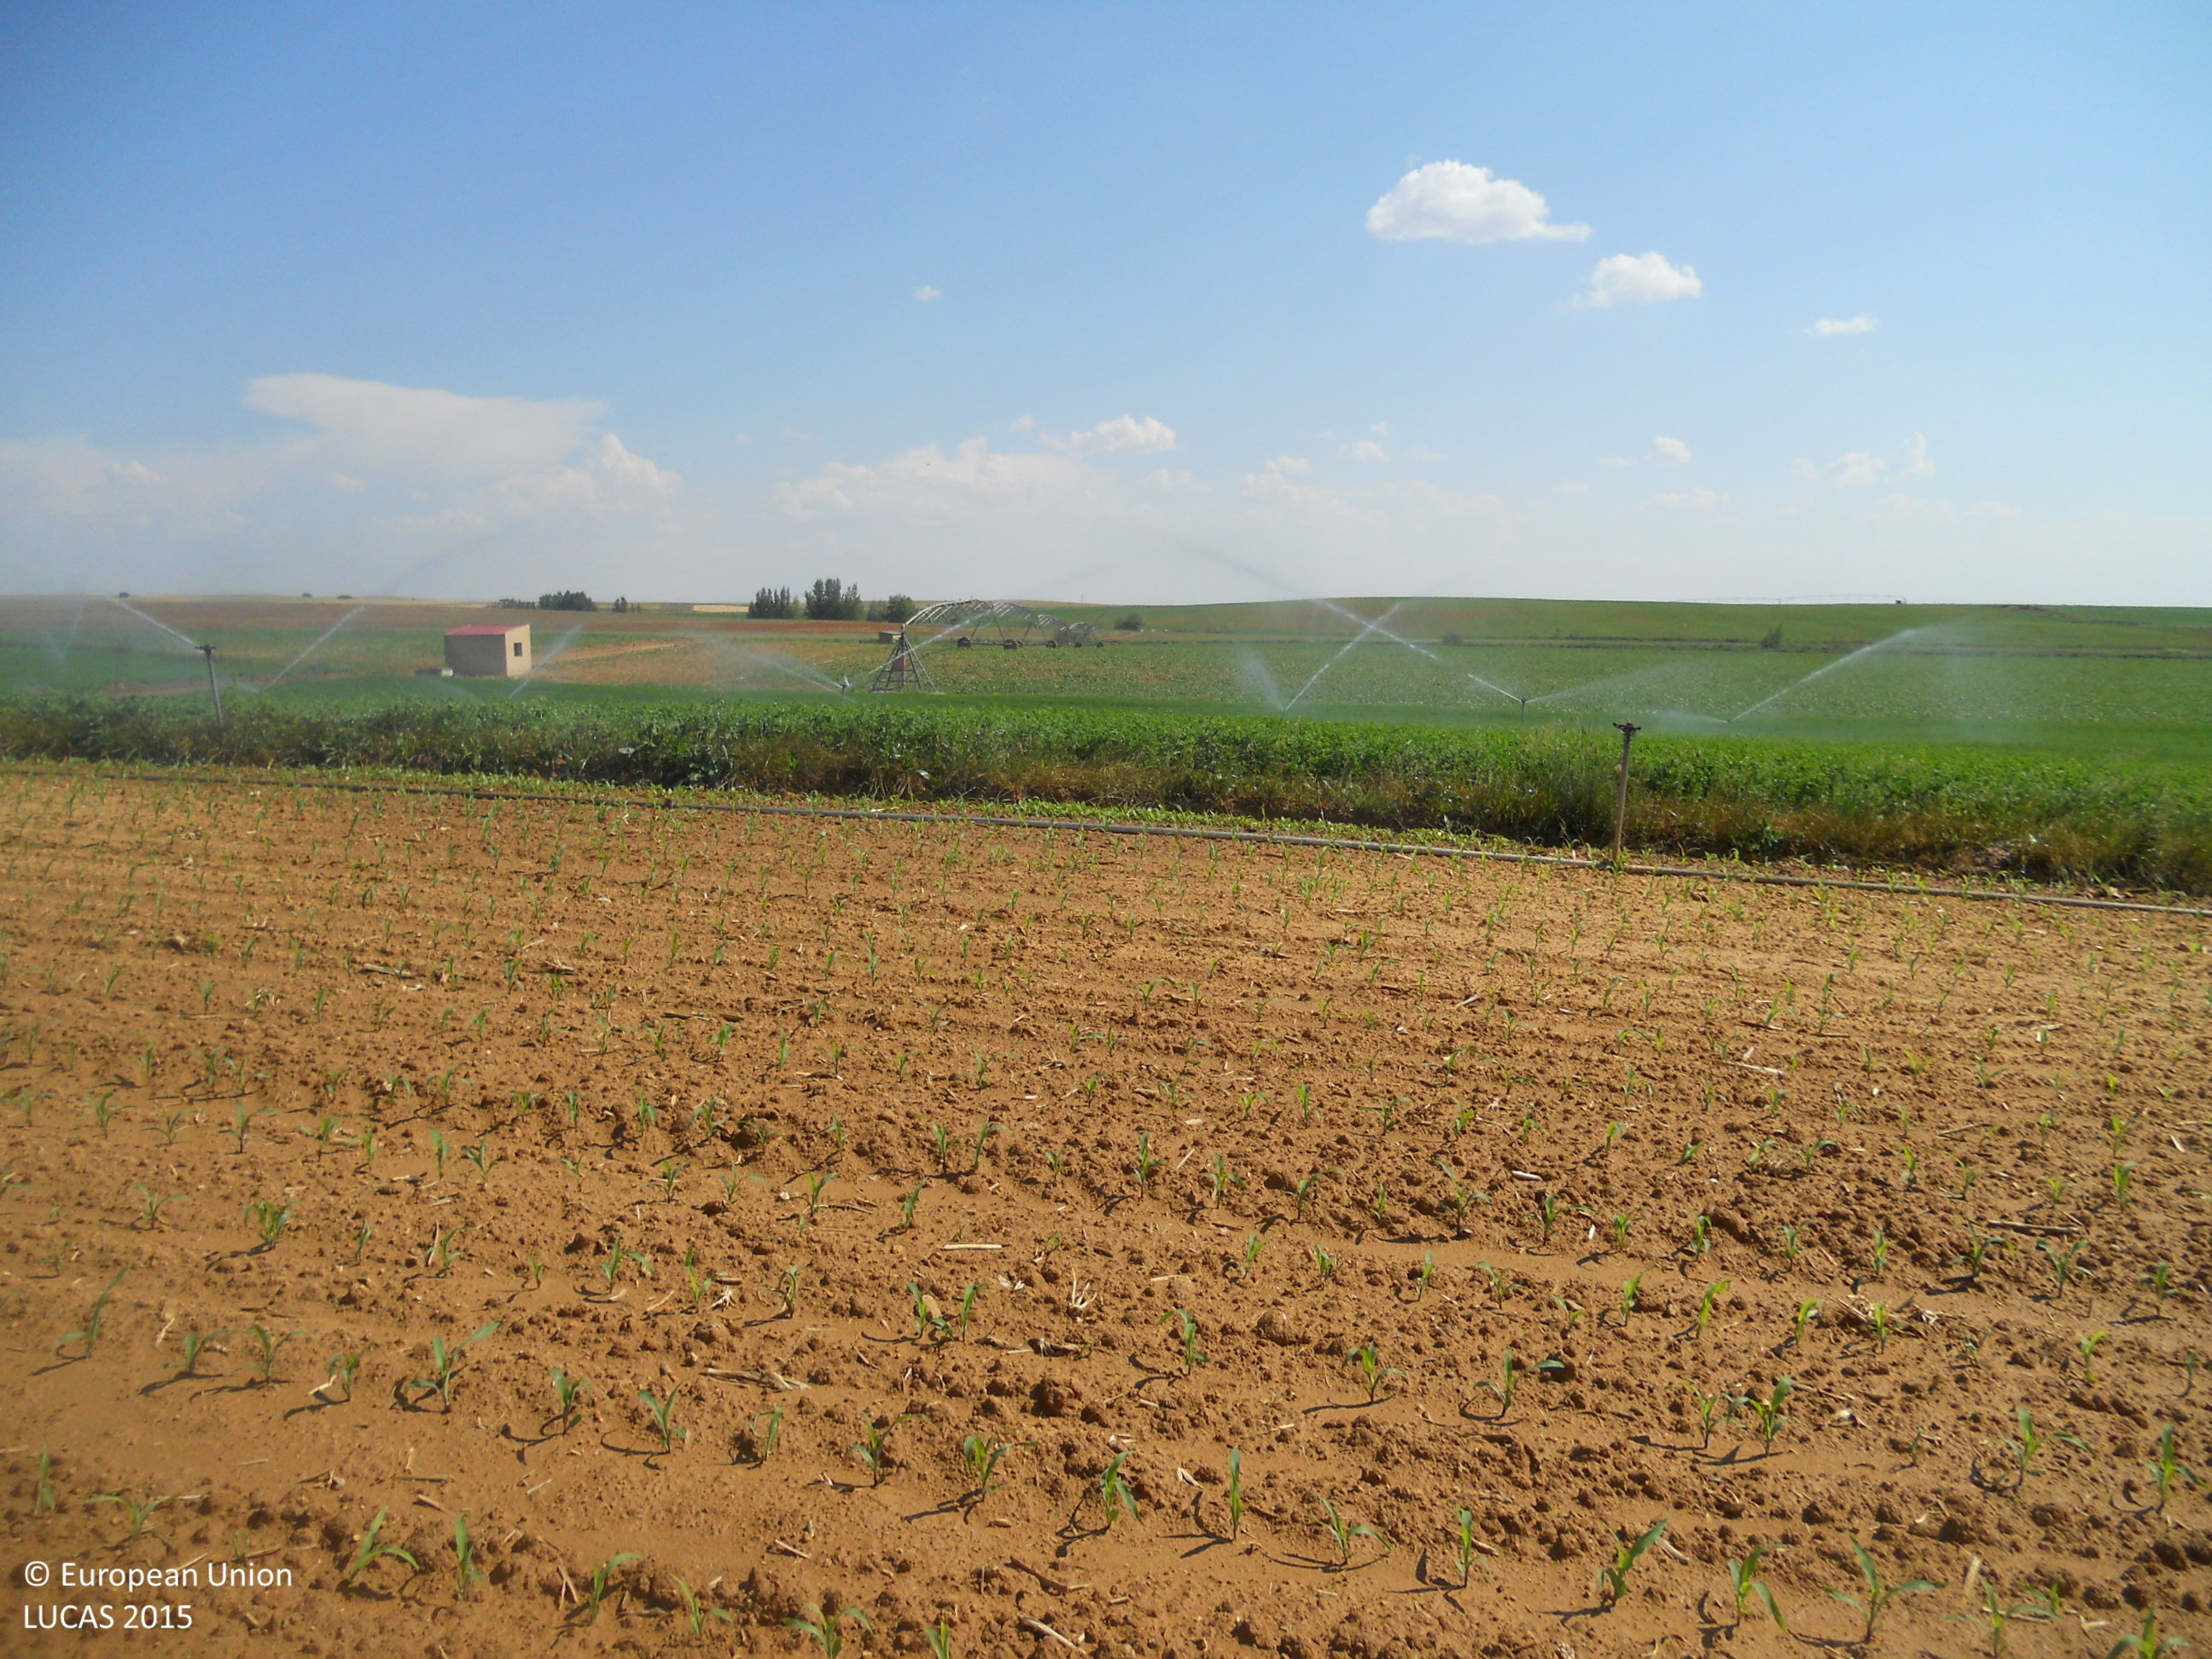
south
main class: Cropland
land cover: Maize
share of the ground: < 10 %
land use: Agriculture (excluding fallow land and kitchen gardens)
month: June
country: ES
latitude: 42.2036
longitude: -5.5088
